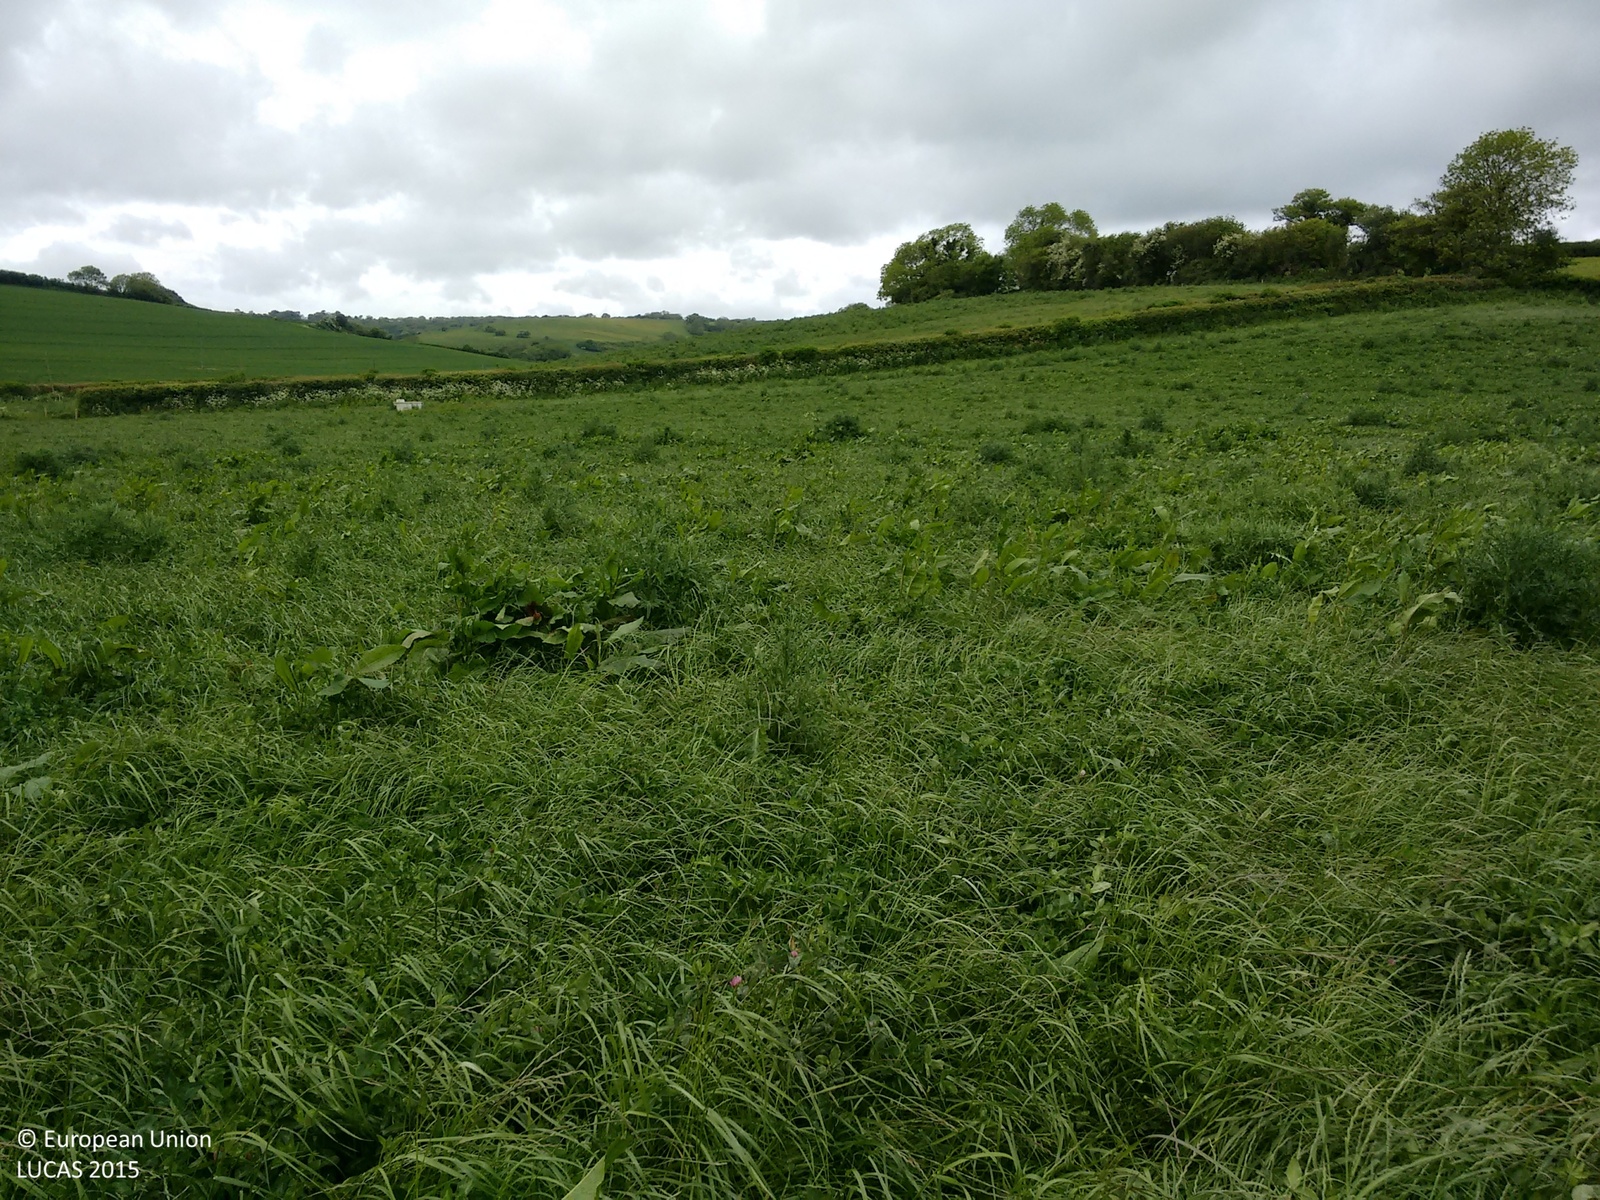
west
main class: Grassland
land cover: Grassland without tree/shrub cover
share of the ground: > 75 %
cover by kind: herbaceous plants 100 %
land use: Agriculture (excluding fallow land and kitchen gardens)
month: June
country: GB
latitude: 50.8292
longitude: -2.4310
